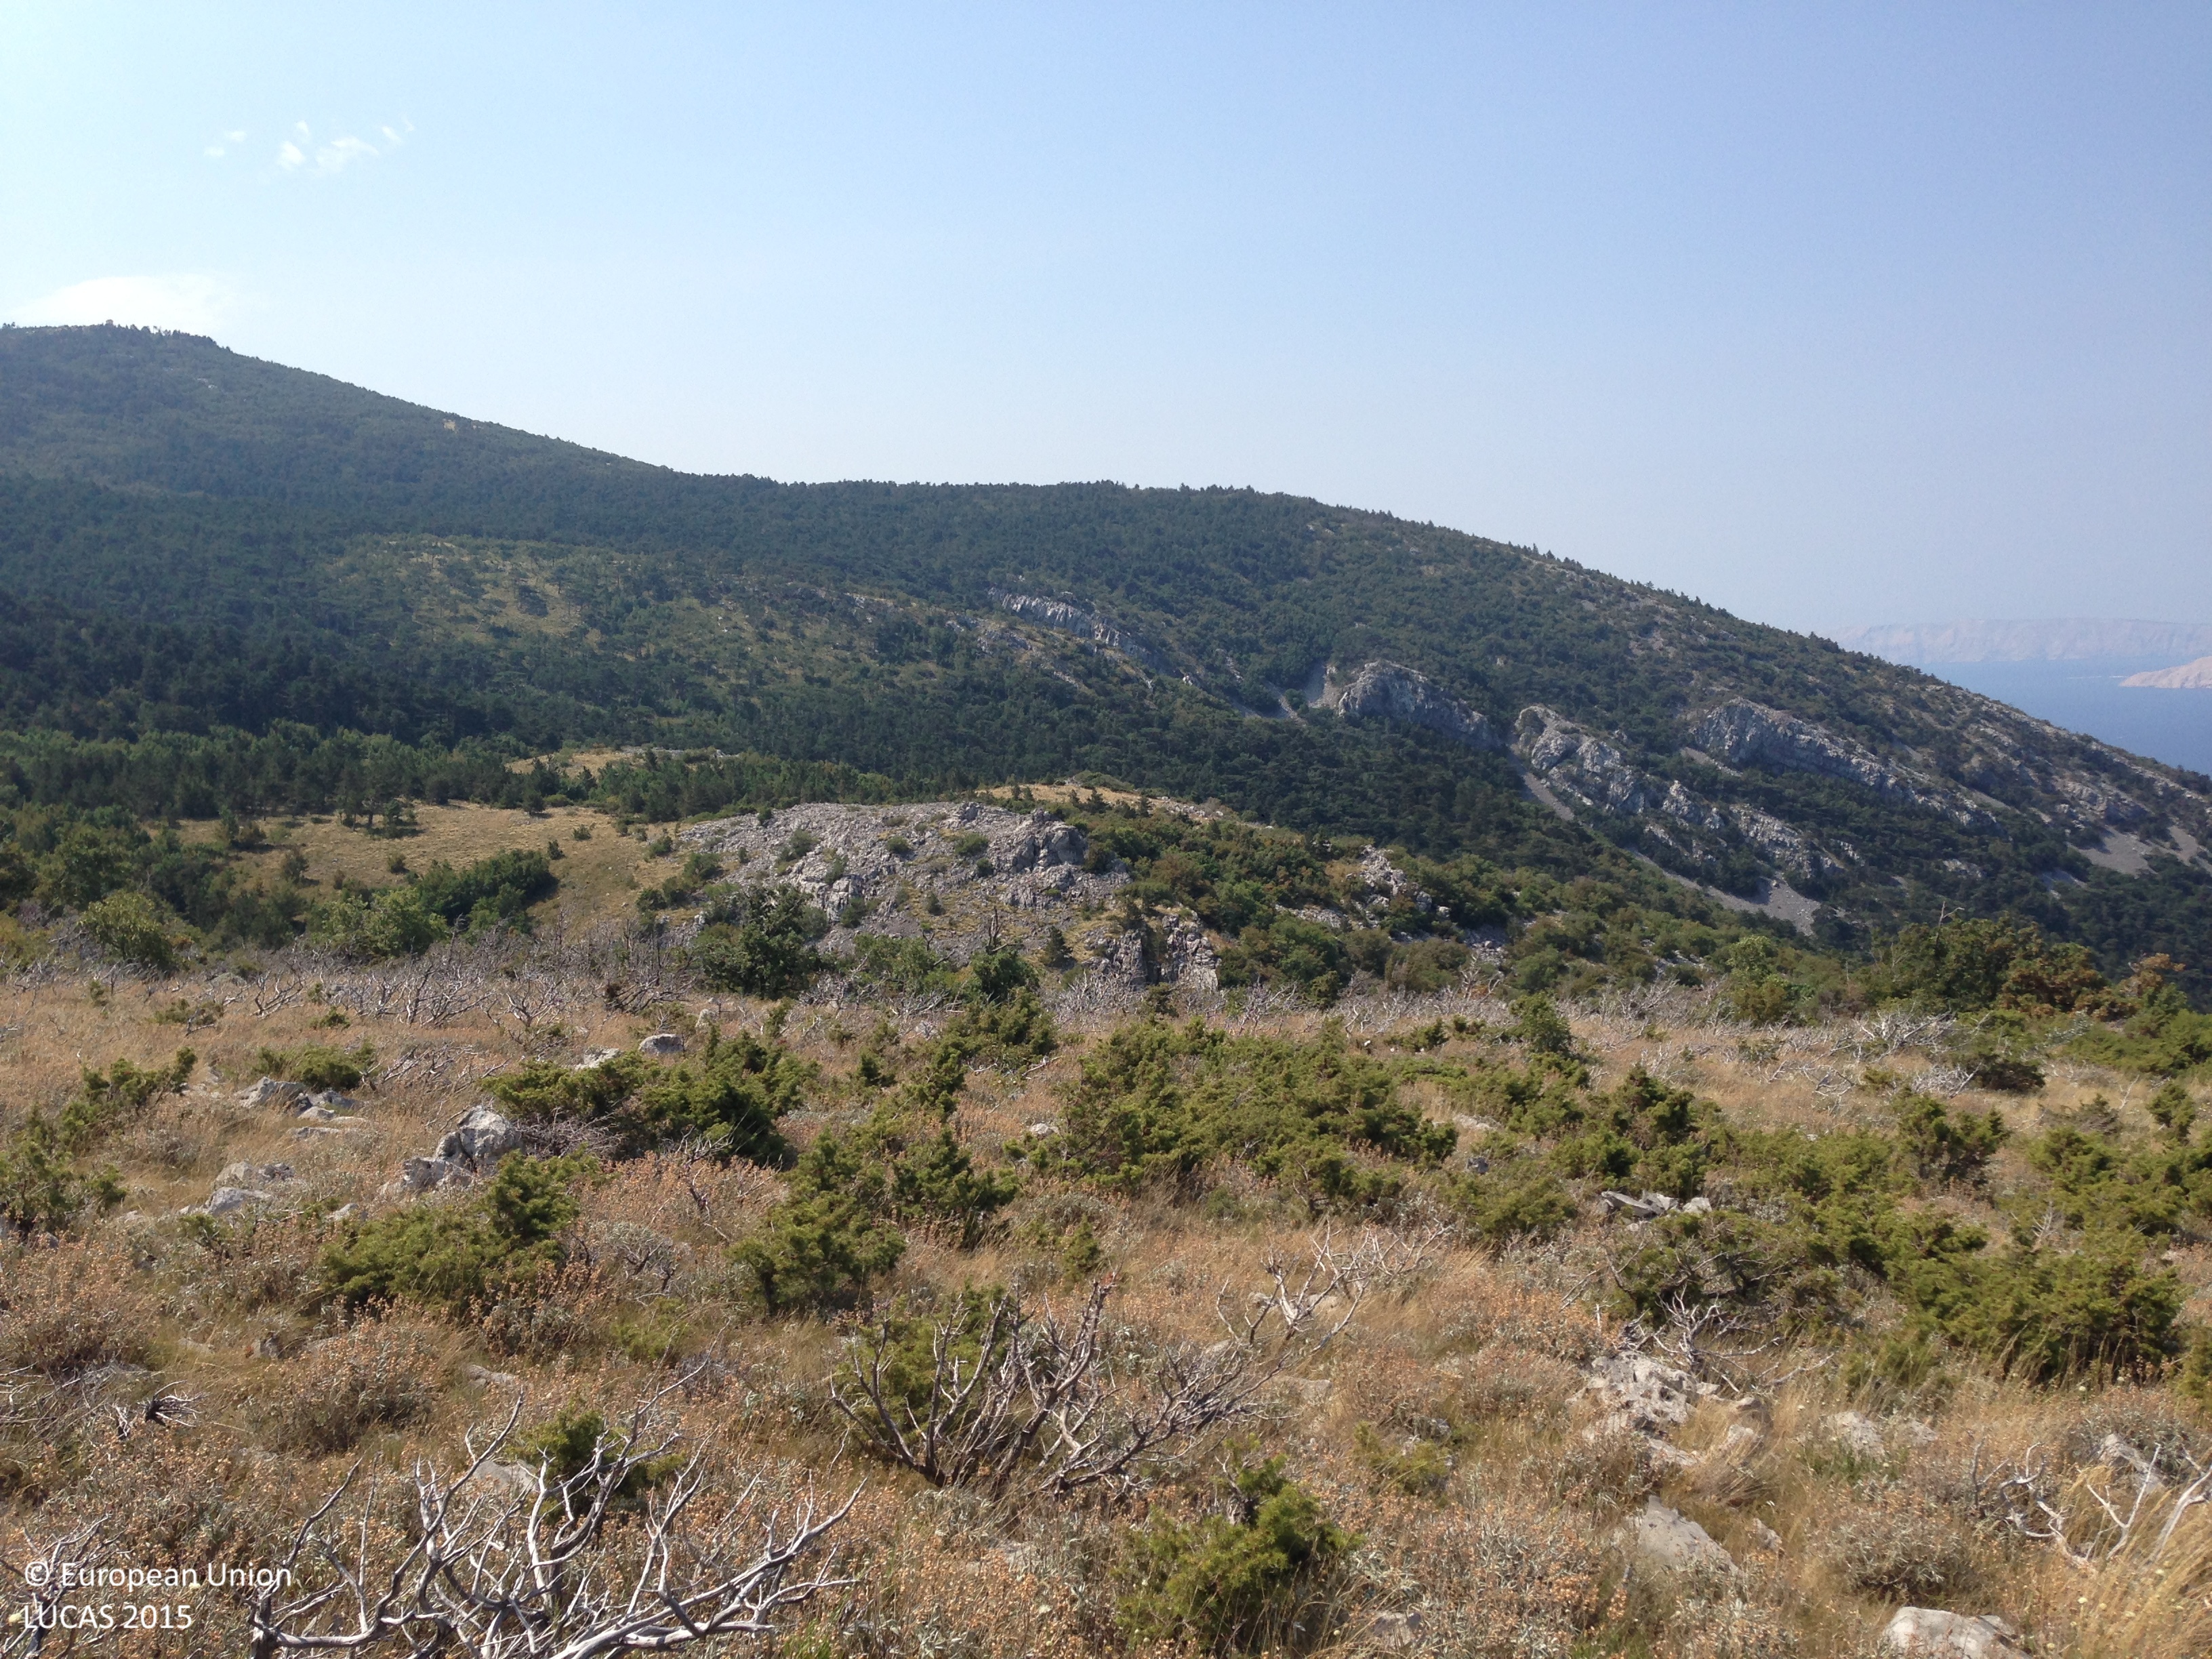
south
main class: Shrubland
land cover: Shrubland with sparse tree cover
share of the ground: 25 - 50 %
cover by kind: shrubs 40 %, herbaceous plants 25 %, unconsolidated bare surface 20 %, consolidated bare surface 10 %, broadleaved forest trees 5 %
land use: Semi-natural and natural areas not in use
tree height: < 5 m
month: July
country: HR
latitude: 44.9370
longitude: 14.9489
